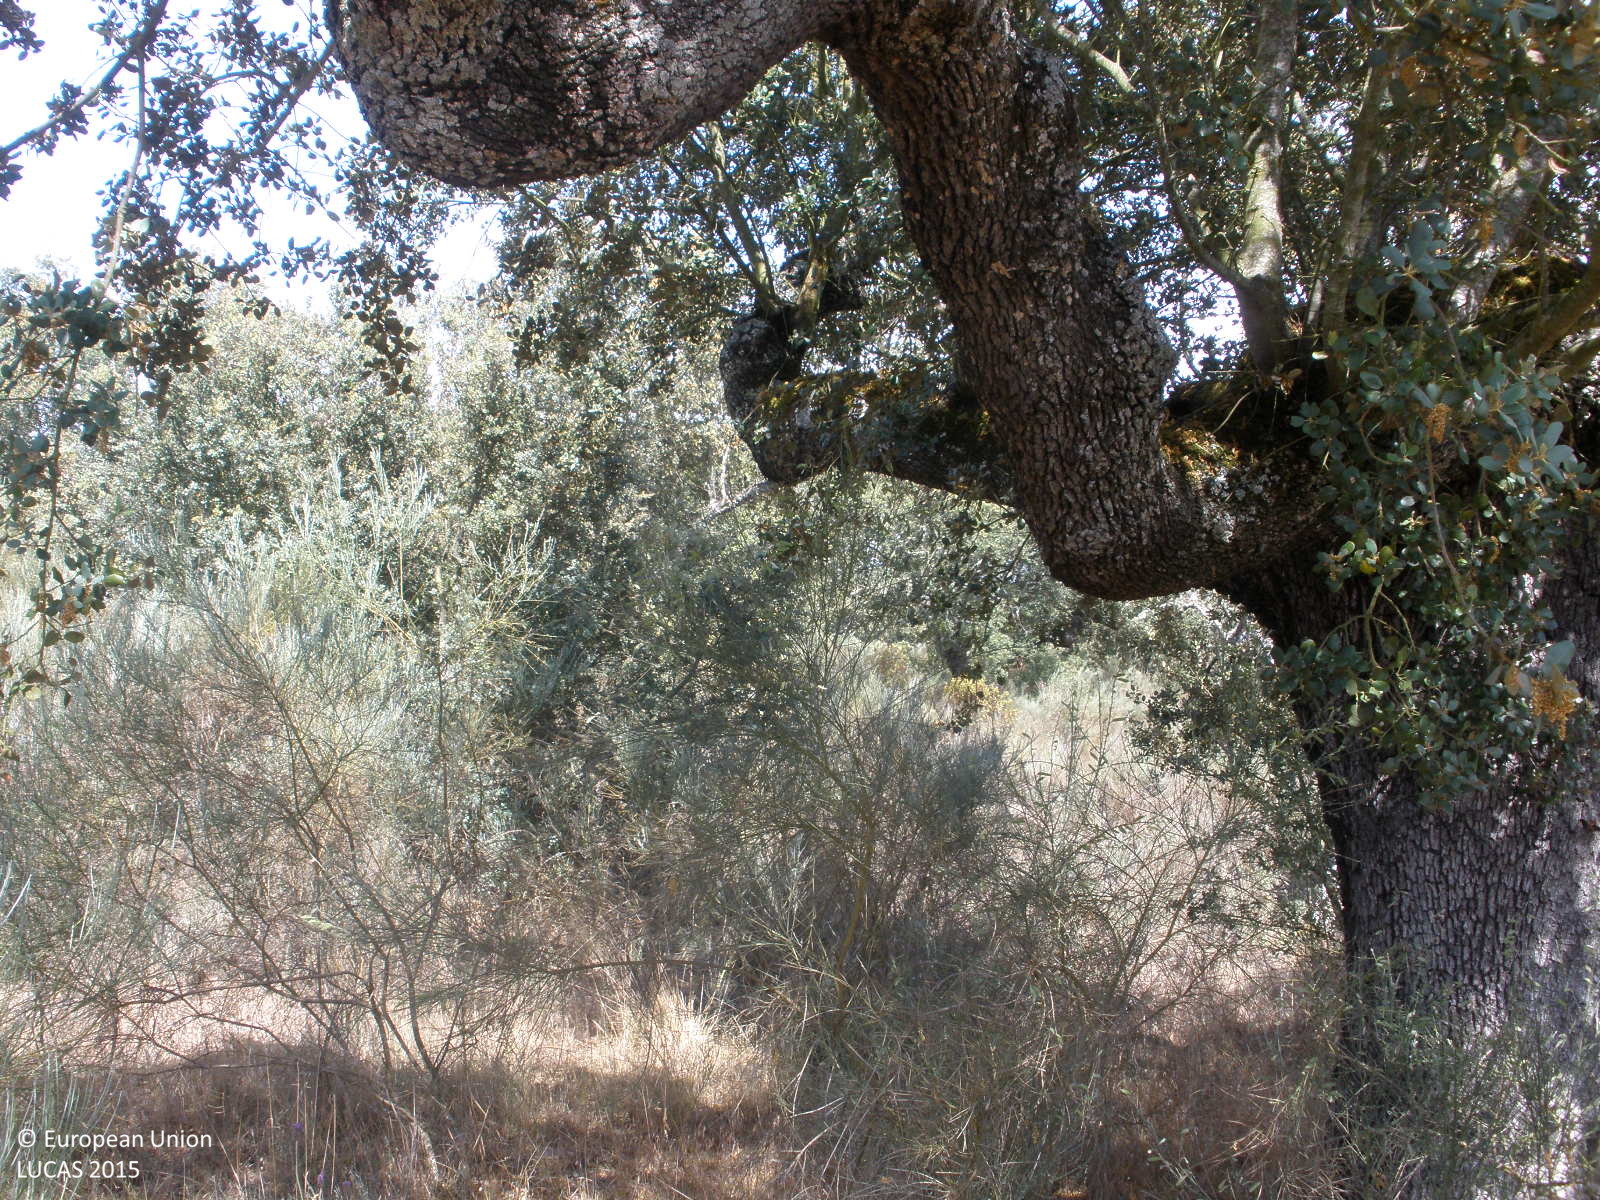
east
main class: Woodland
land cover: Broadleaved woodland
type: broadleaved evergreen forest
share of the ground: > 75 %
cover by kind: shrubs 50 %, broadleaved forest trees 40 %, herbaceous plants 10 %
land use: Semi-natural and natural areas not in use
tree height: > 5 m
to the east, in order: Broadleaved woodland; Shrubland with sparse tree cover; Paved roads, cycling and walking lanes; Shrubland without tree cover; Fences; Broadleaved woodland
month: June
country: ES
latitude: 40.5941
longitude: -6.6952
